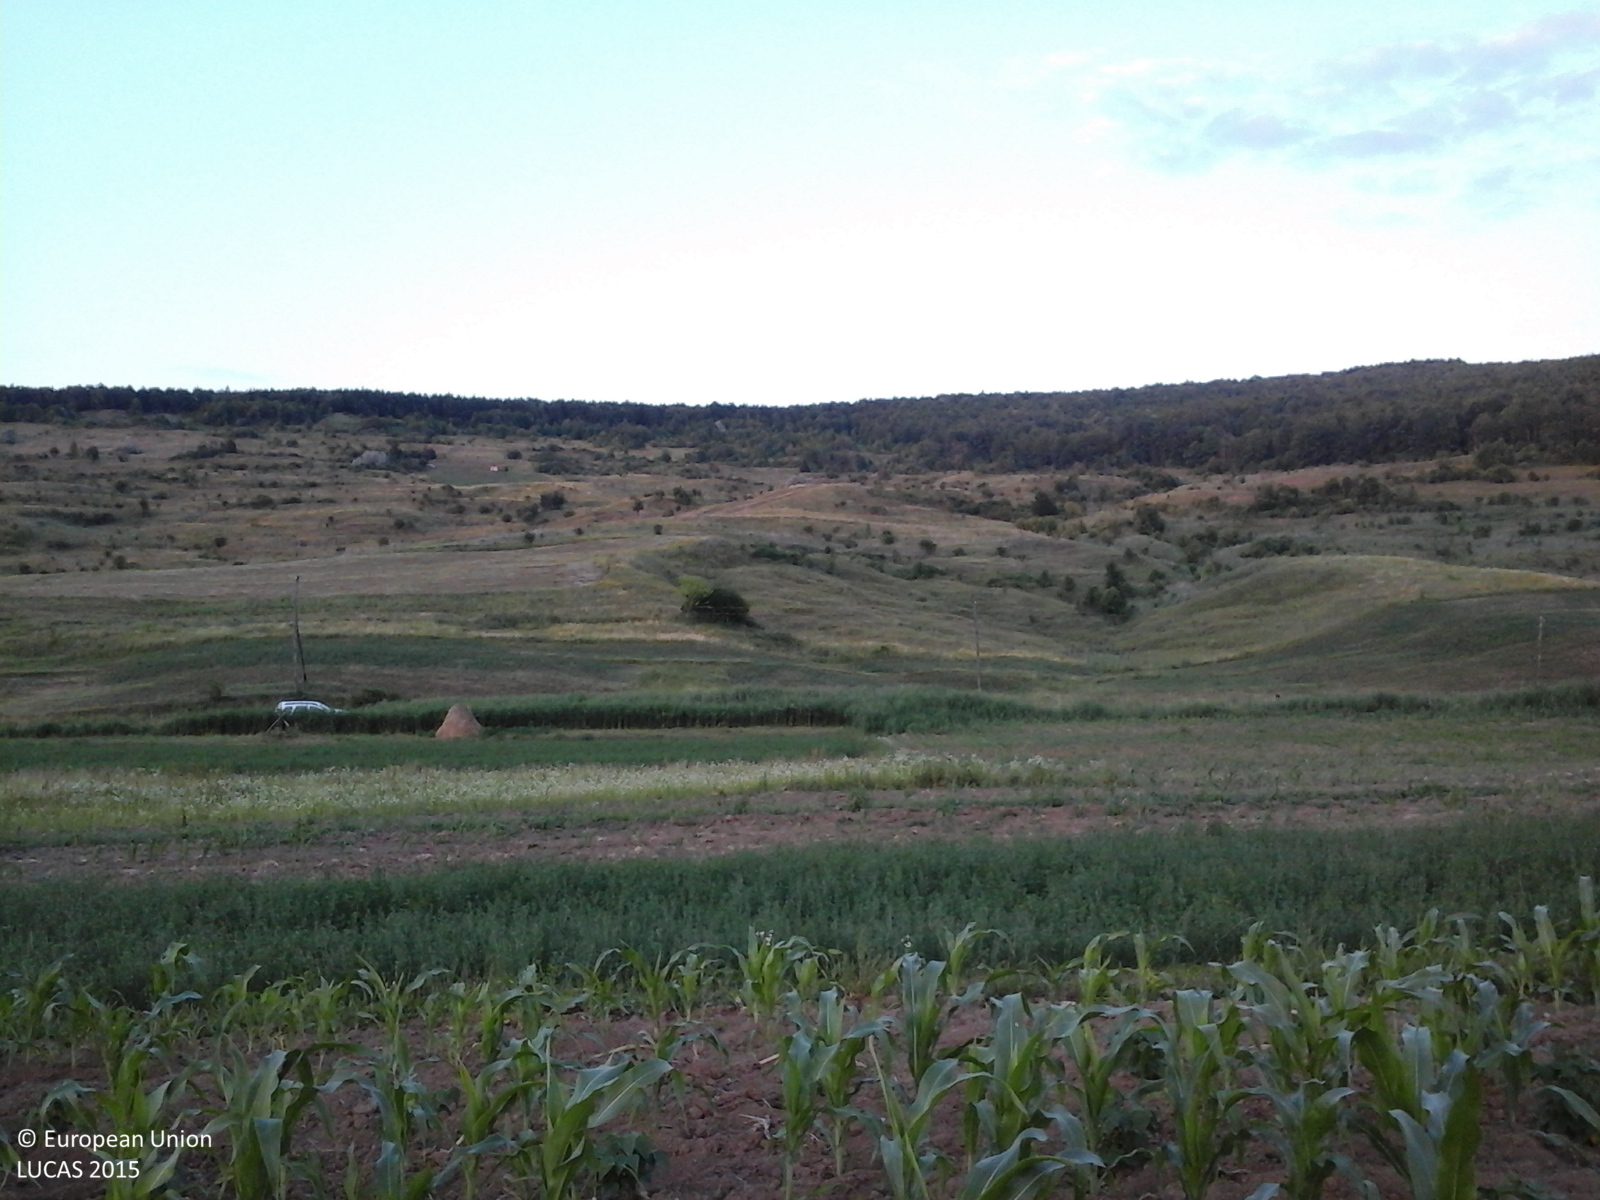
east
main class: Cropland
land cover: Maize
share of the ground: 25 - 50 %
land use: Agriculture (excluding fallow land and kitchen gardens)
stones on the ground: < 10 %
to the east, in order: Maize; Lucerne; Maize; Grassland without tree/shrub cover; Lucerne; Spontaneously vegetated surfaces; Ditches and canals; Spontaneously vegetated surfaces; Tracks; Electric lines; Grassland without tree/shrub cover; Grassland with sparse tree/shrub cover
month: June
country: RO
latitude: 47.6033
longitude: 26.7908
